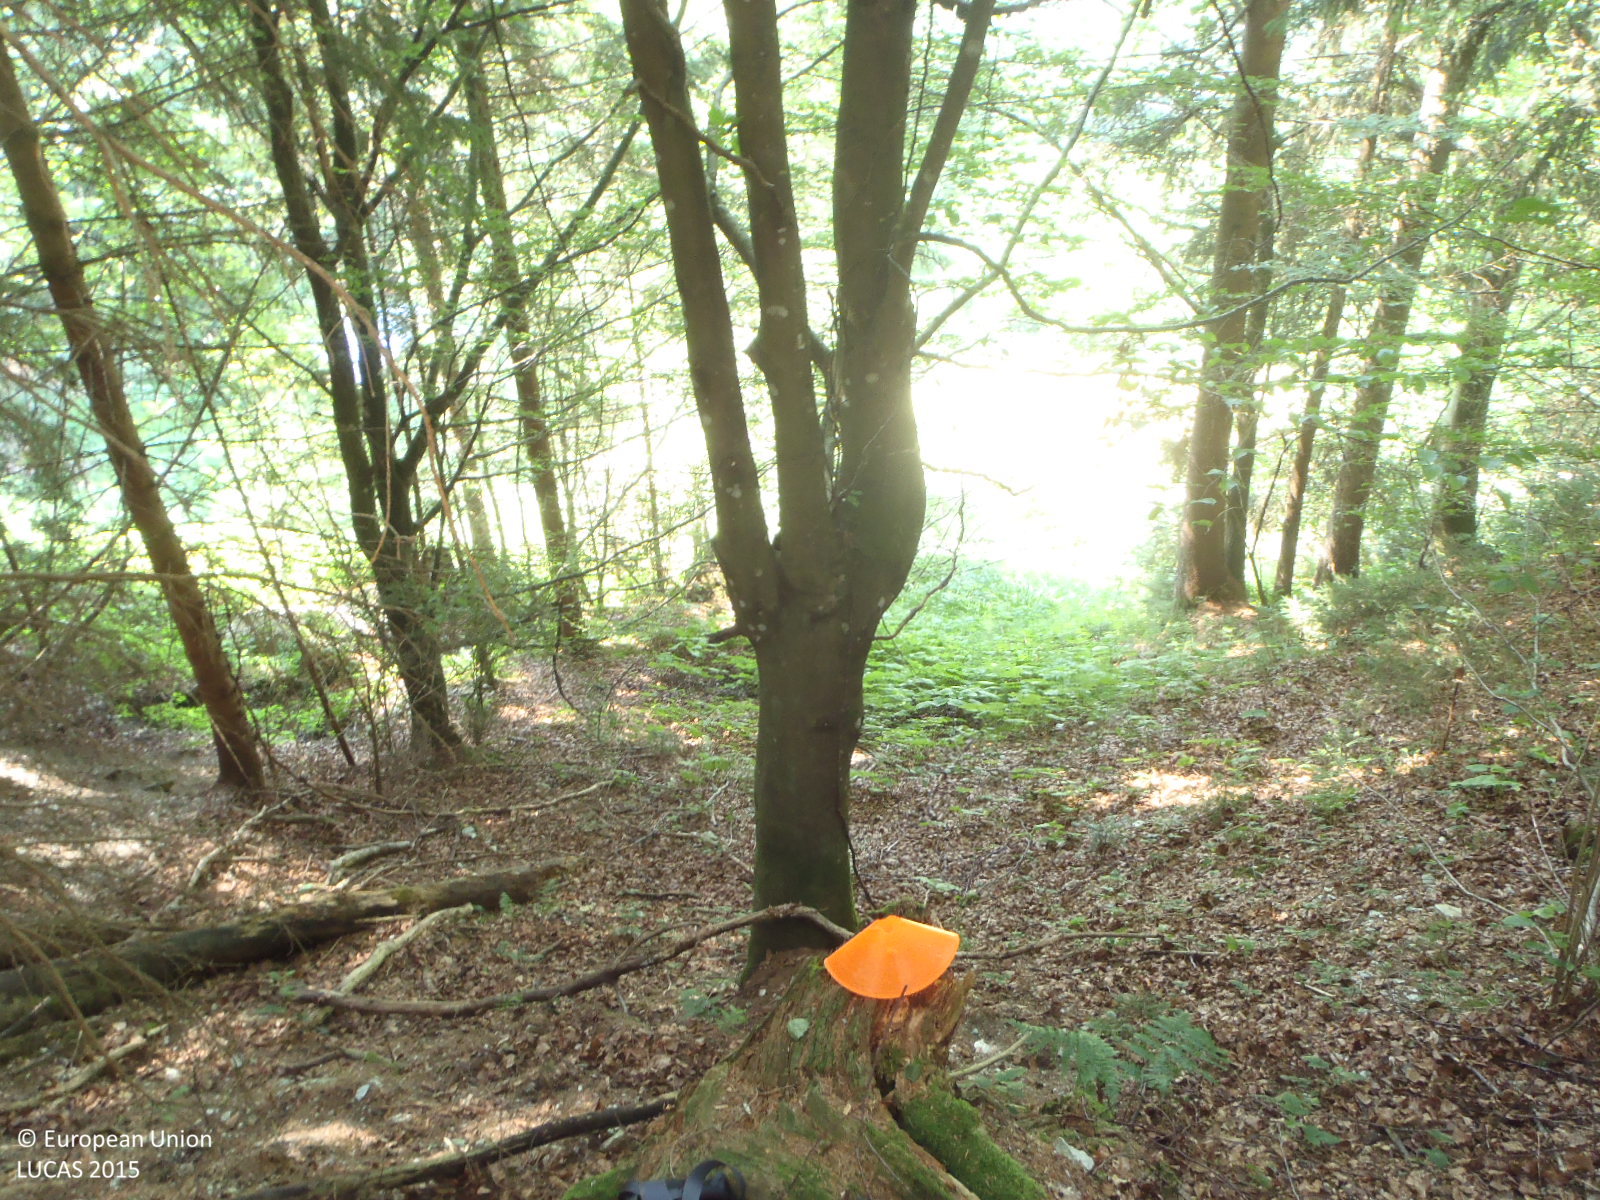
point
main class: Woodland
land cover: Spruce dominated mixed woodland
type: alpine coniferous forest
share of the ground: > 75 %
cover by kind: coniferous forest trees 60 %, broadleaved forest trees 30 %, shrubs 10 %
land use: Forestry
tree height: > 5 m
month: July
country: AT
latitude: 47.4592
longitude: 12.3993
